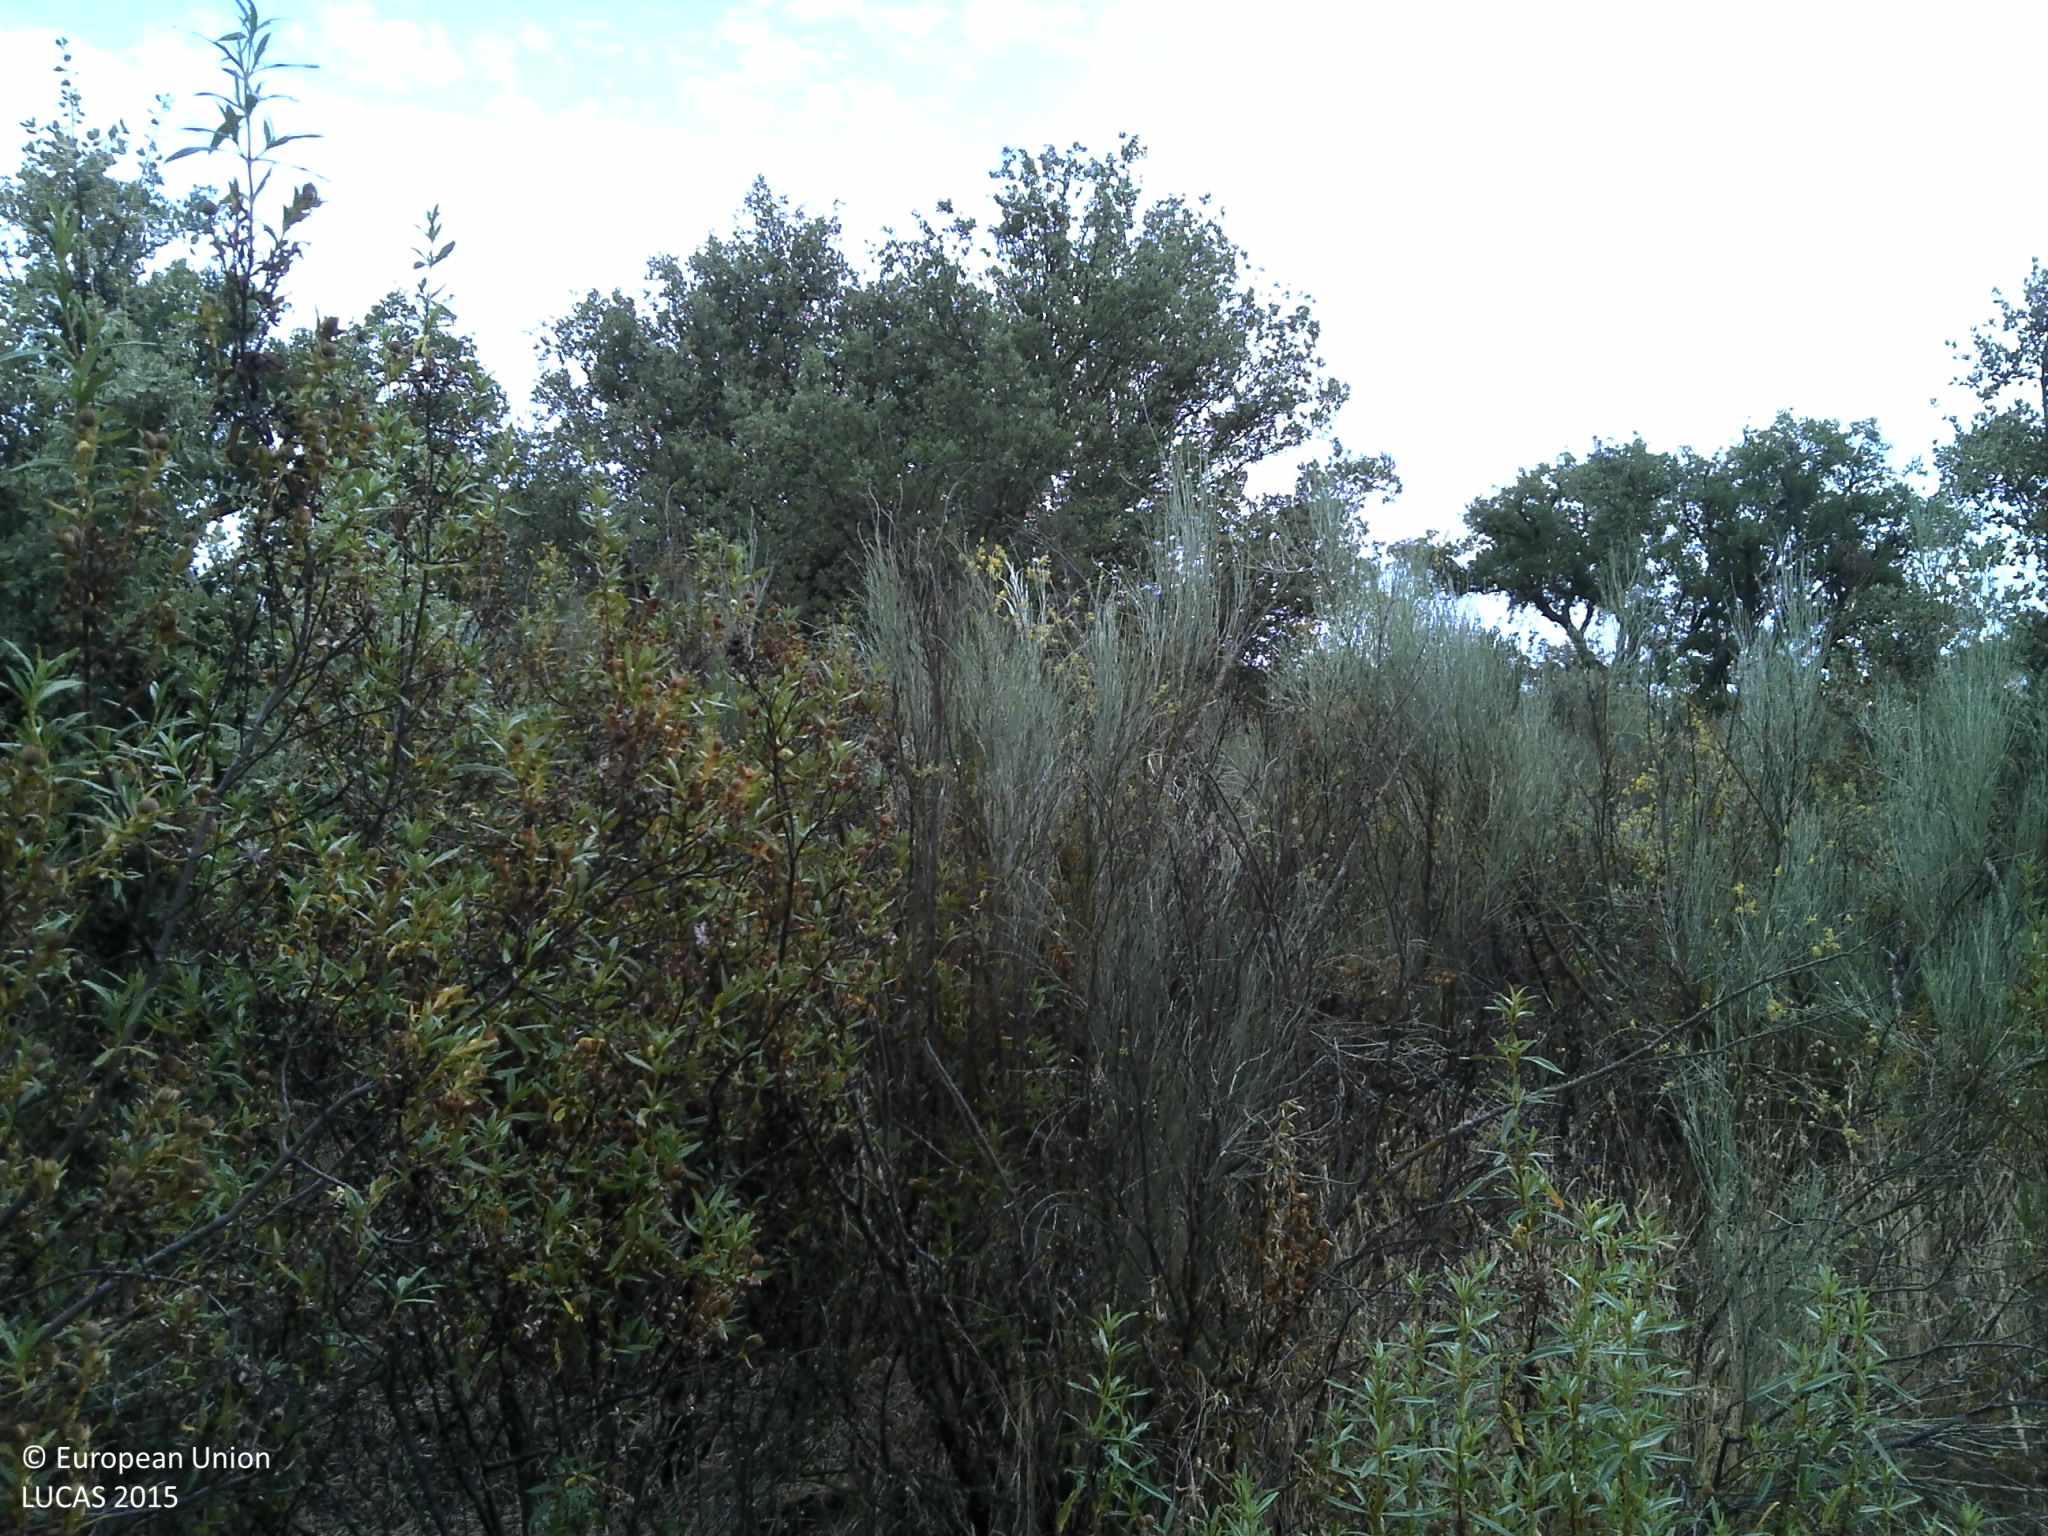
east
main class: Woodland
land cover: Broadleaved woodland
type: broadleaved evergreen forest
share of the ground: 10 - 25 %
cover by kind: shrubs 75 %, broadleaved forest trees 15 %, herbaceous plants 10 %
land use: Forestry
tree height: > 5 m
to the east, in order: Broadleaved woodland; Shrubland without tree cover; Broadleaved woodland
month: June
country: PT
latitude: 38.5799
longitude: -7.8421
